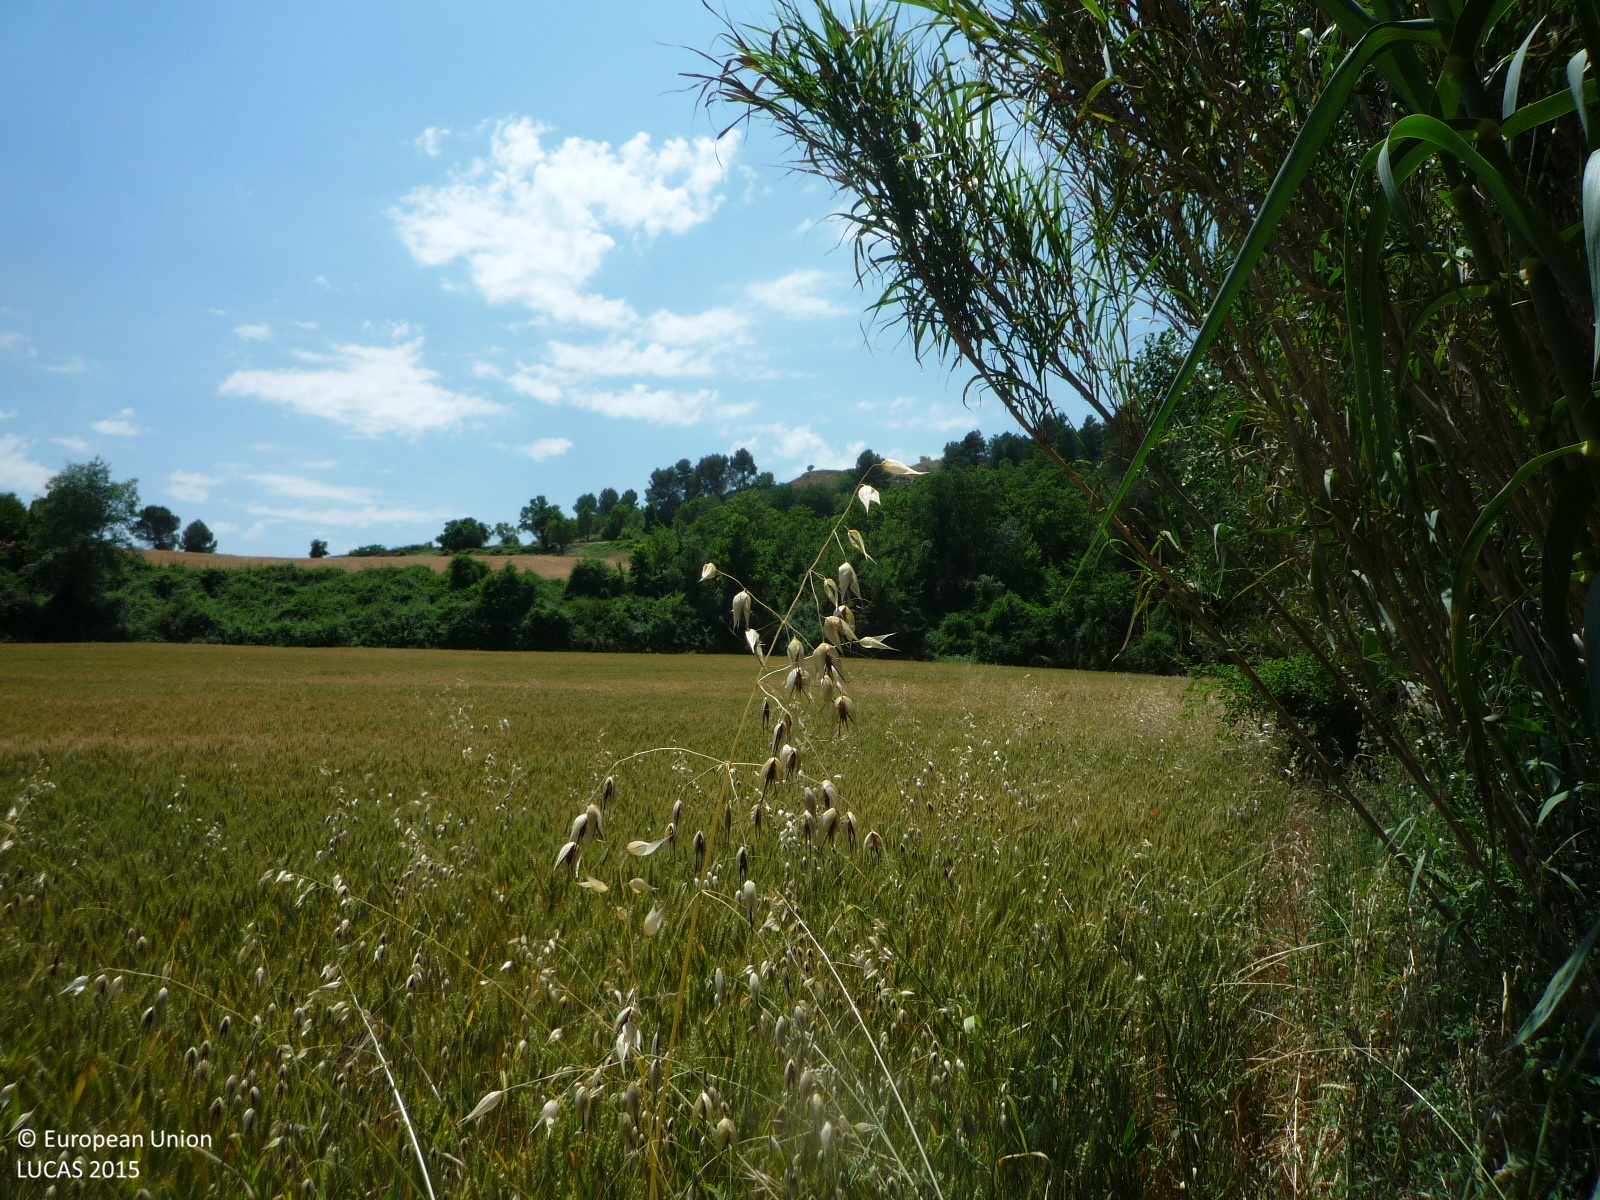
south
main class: Shrubland
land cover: Shrubland with sparse tree cover
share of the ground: > 75 %
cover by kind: shrubs 95 %, broadleaved forest trees 5 %
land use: Semi-natural and natural areas not in use
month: June
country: ES
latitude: 41.8080
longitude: 1.9625
